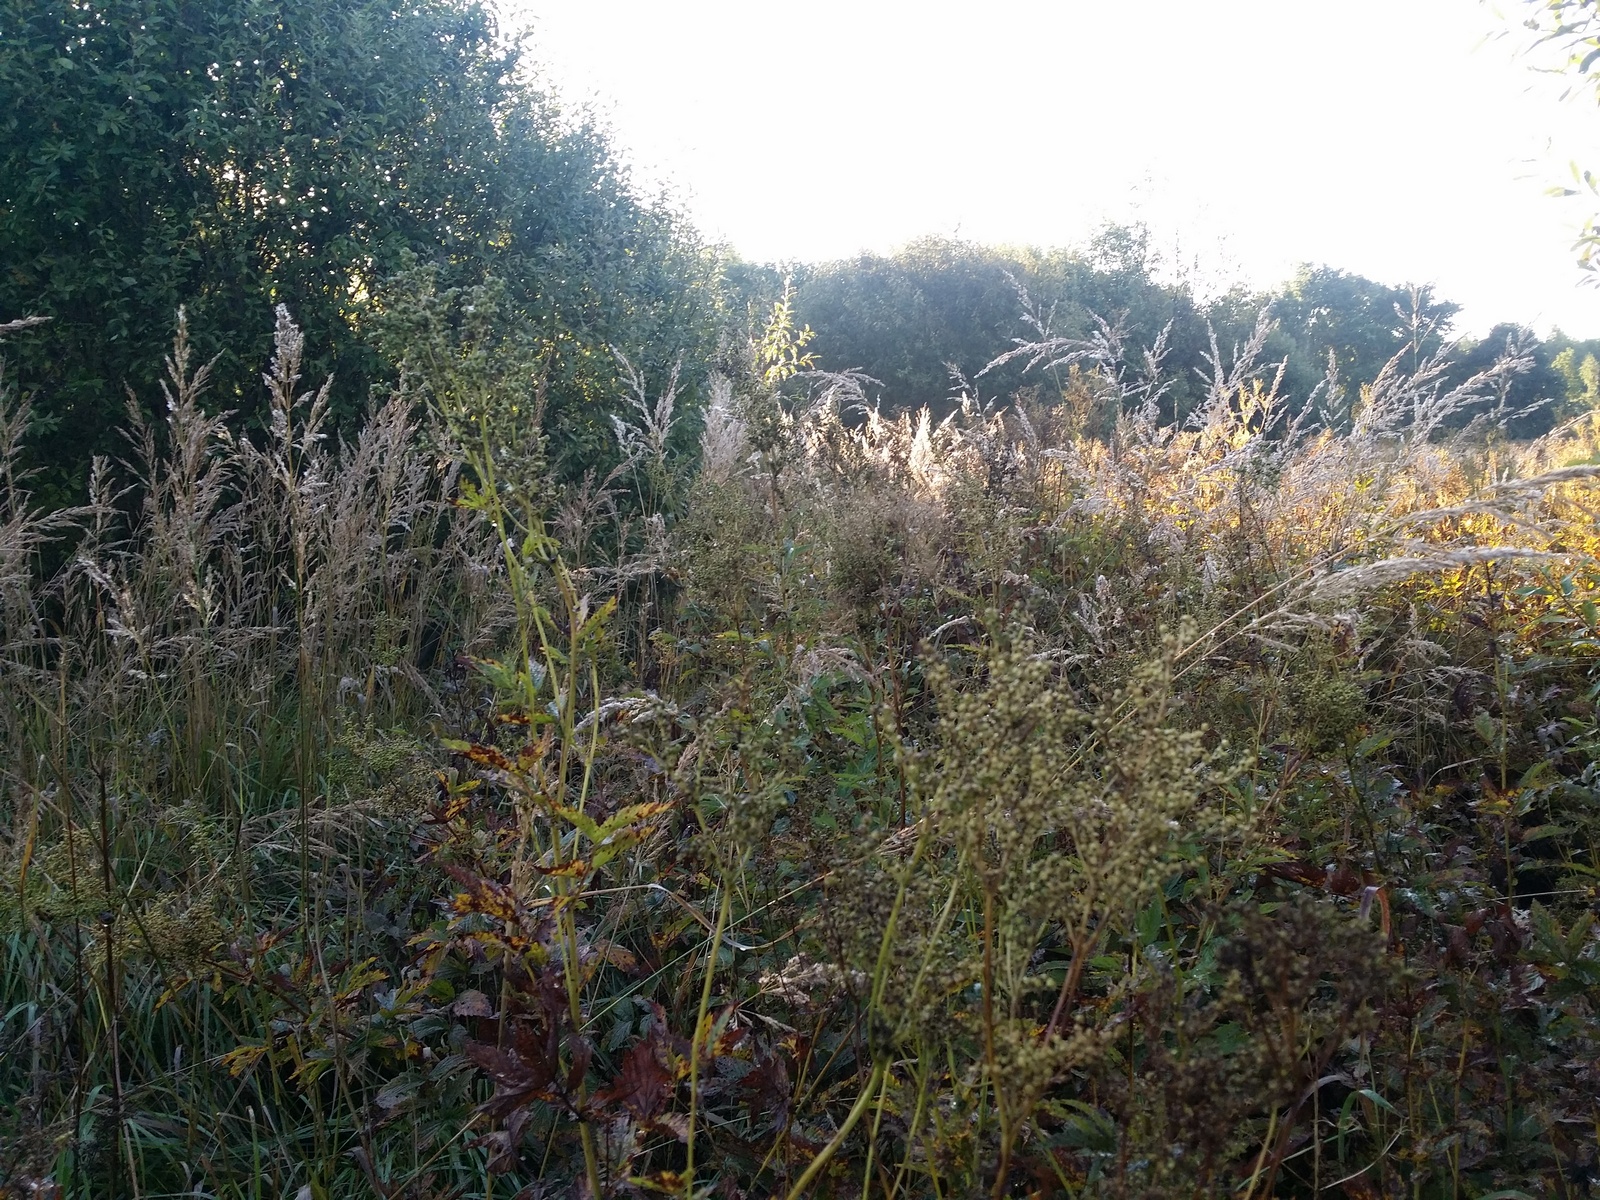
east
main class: Shrubland
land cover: Shrubland without tree cover
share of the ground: 25 - 50 %
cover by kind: herbaceous plants 65 %, shrubs 35 %
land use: Semi-natural and natural areas not in use
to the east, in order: Shrubland without tree cover; Spontaneously vegetated surfaces; Grassland with sparse tree/shrub cover; Spontaneously vegetated surfaces; Broadleaved woodland
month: September
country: LV
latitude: 57.0645
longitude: 27.1680
